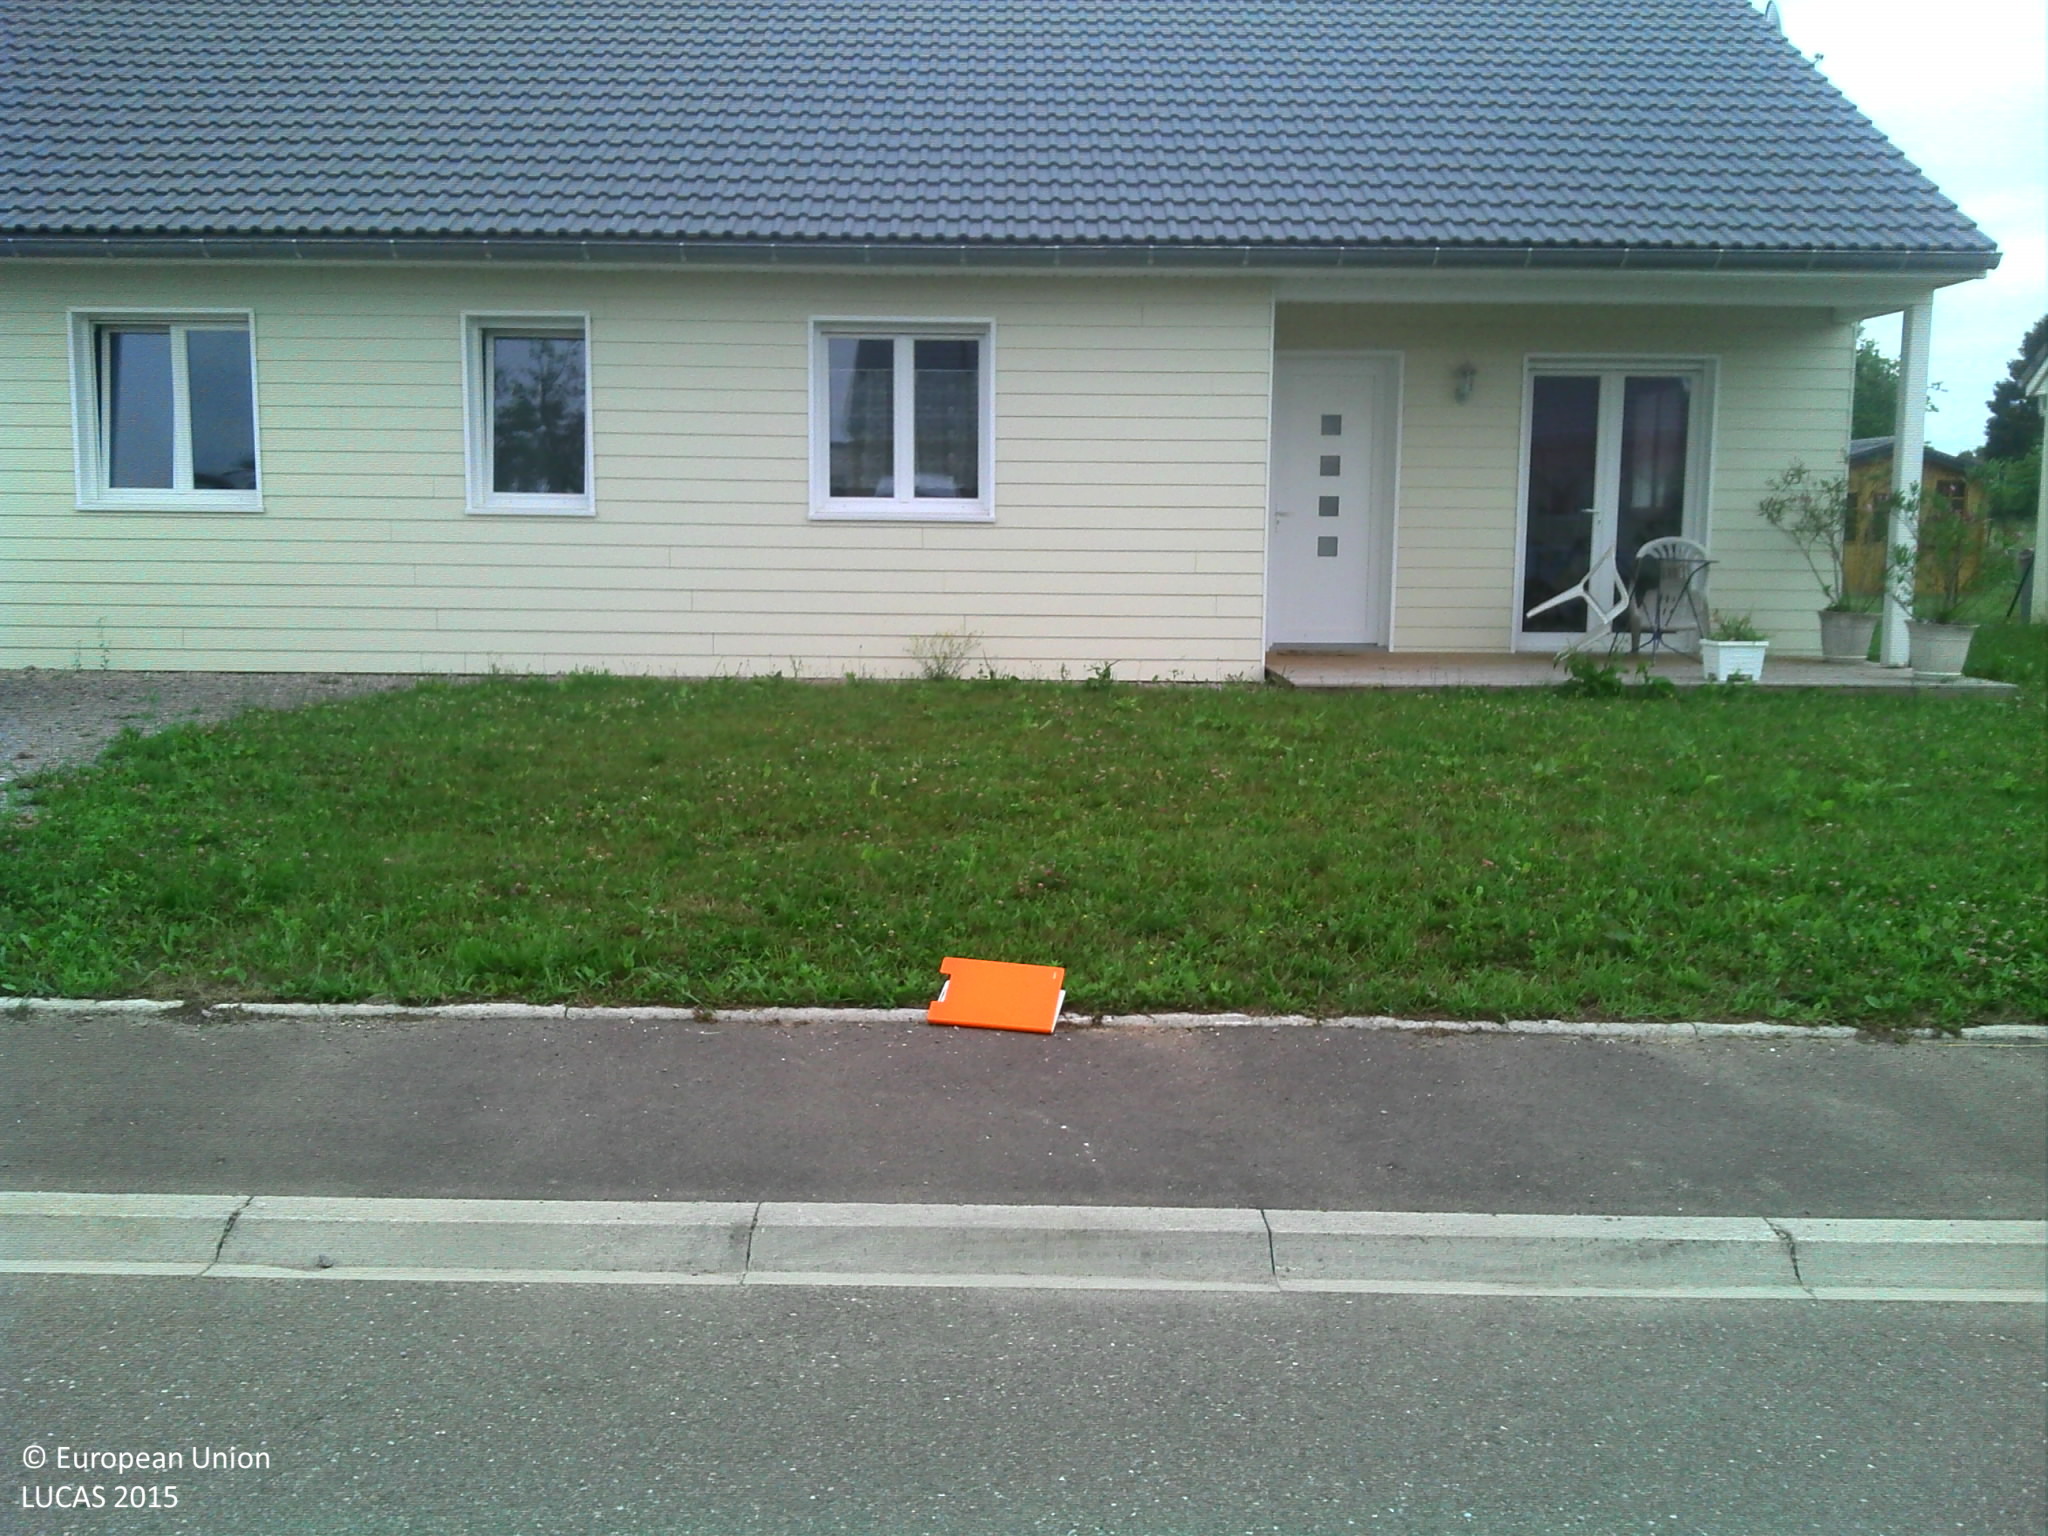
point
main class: Grassland
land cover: Grassland without tree/shrub cover
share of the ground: > 75 %
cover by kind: herbaceous plants 100 %
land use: Residential
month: June
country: FR
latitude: 47.8920
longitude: 6.3229
